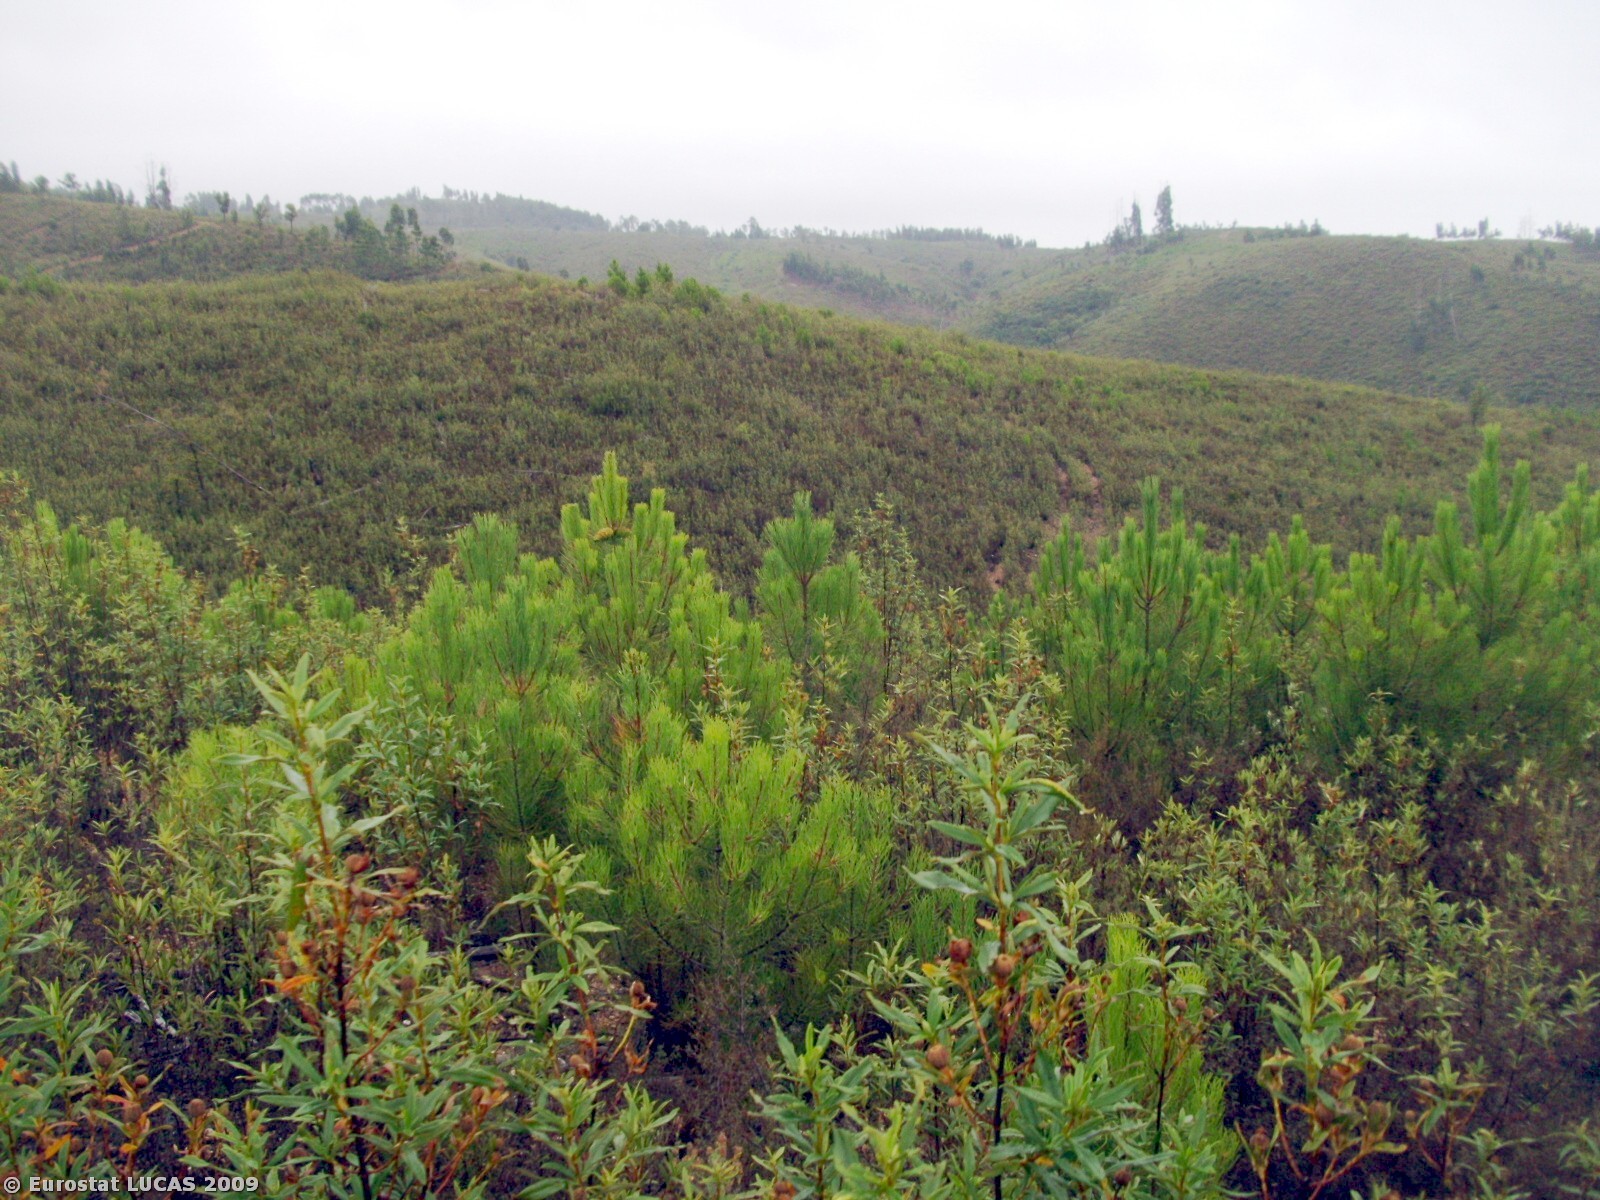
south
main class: Shrubland
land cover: Shrubland with sparse tree cover
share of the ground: > 75 %
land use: Unused
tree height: > 5 m
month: July
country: PT
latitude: 39.7162
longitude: -8.0881
